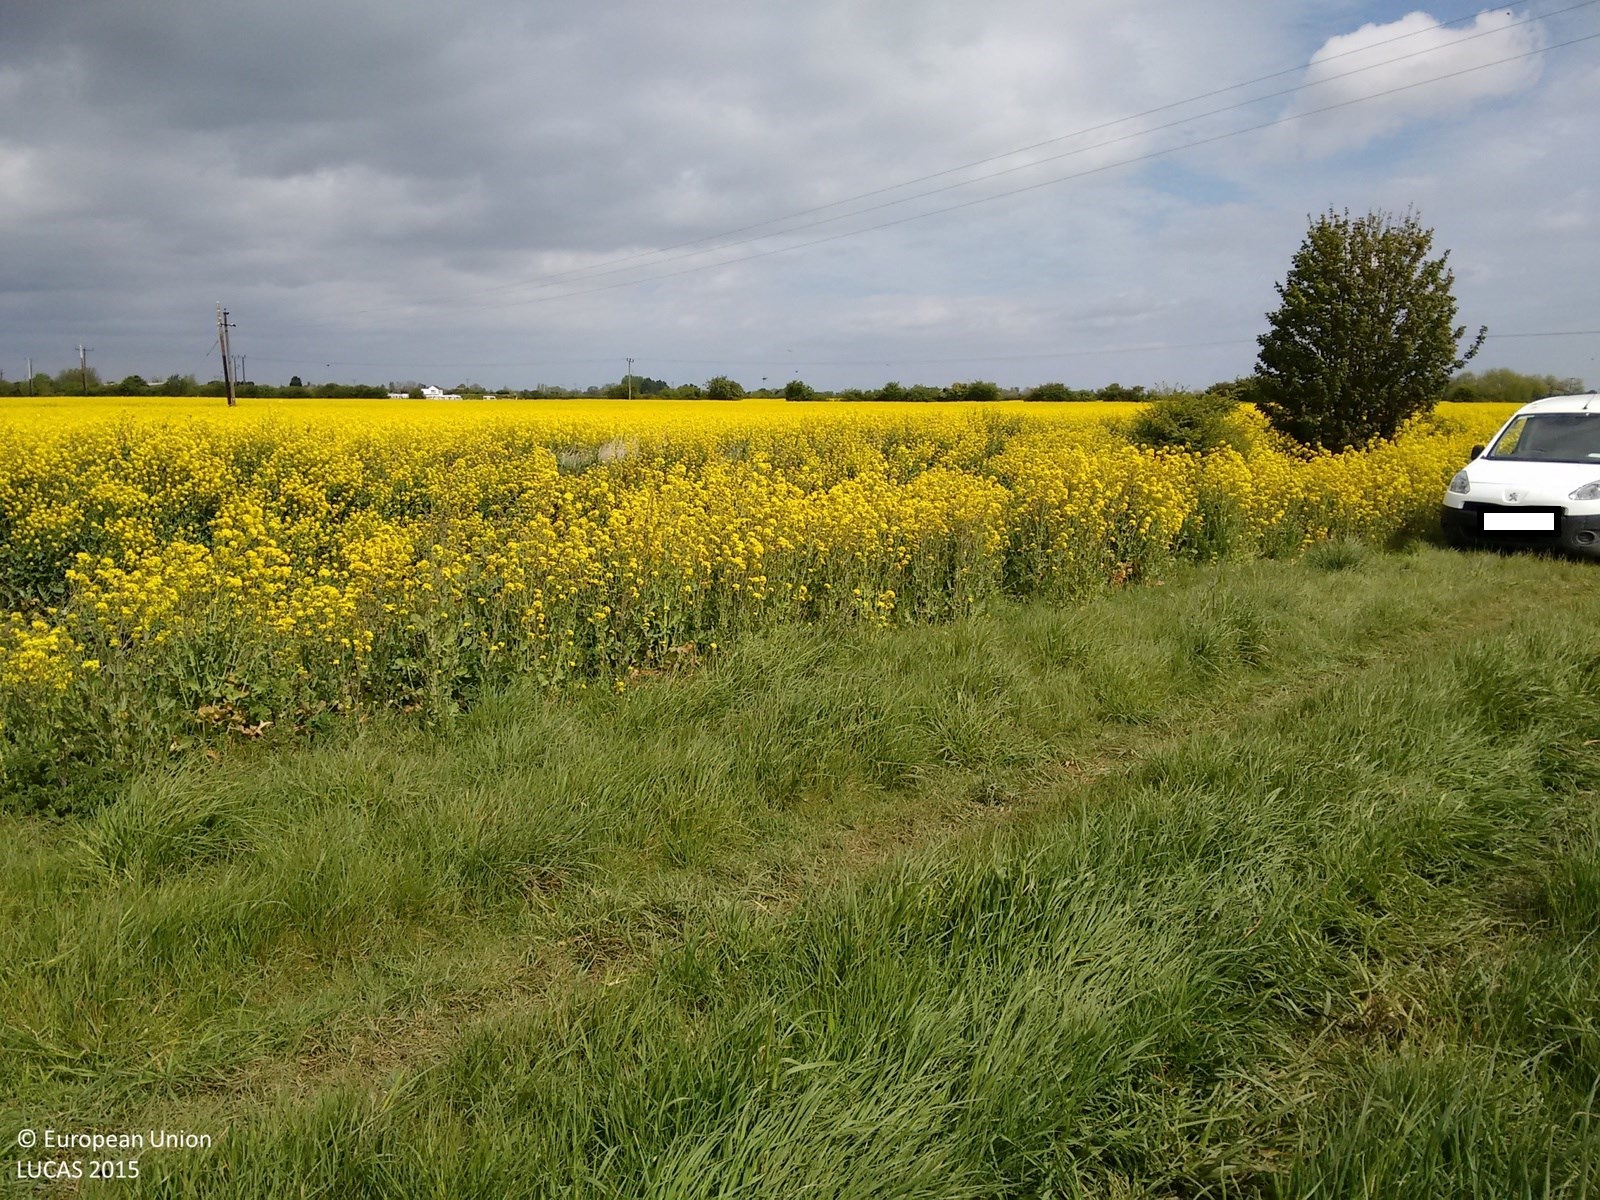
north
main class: Cropland
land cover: Rape and turnip rape
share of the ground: > 75 %
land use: Agriculture (excluding fallow land and kitchen gardens)
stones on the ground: < 10 %
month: May
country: GB
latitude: 53.2120
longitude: 0.3129
